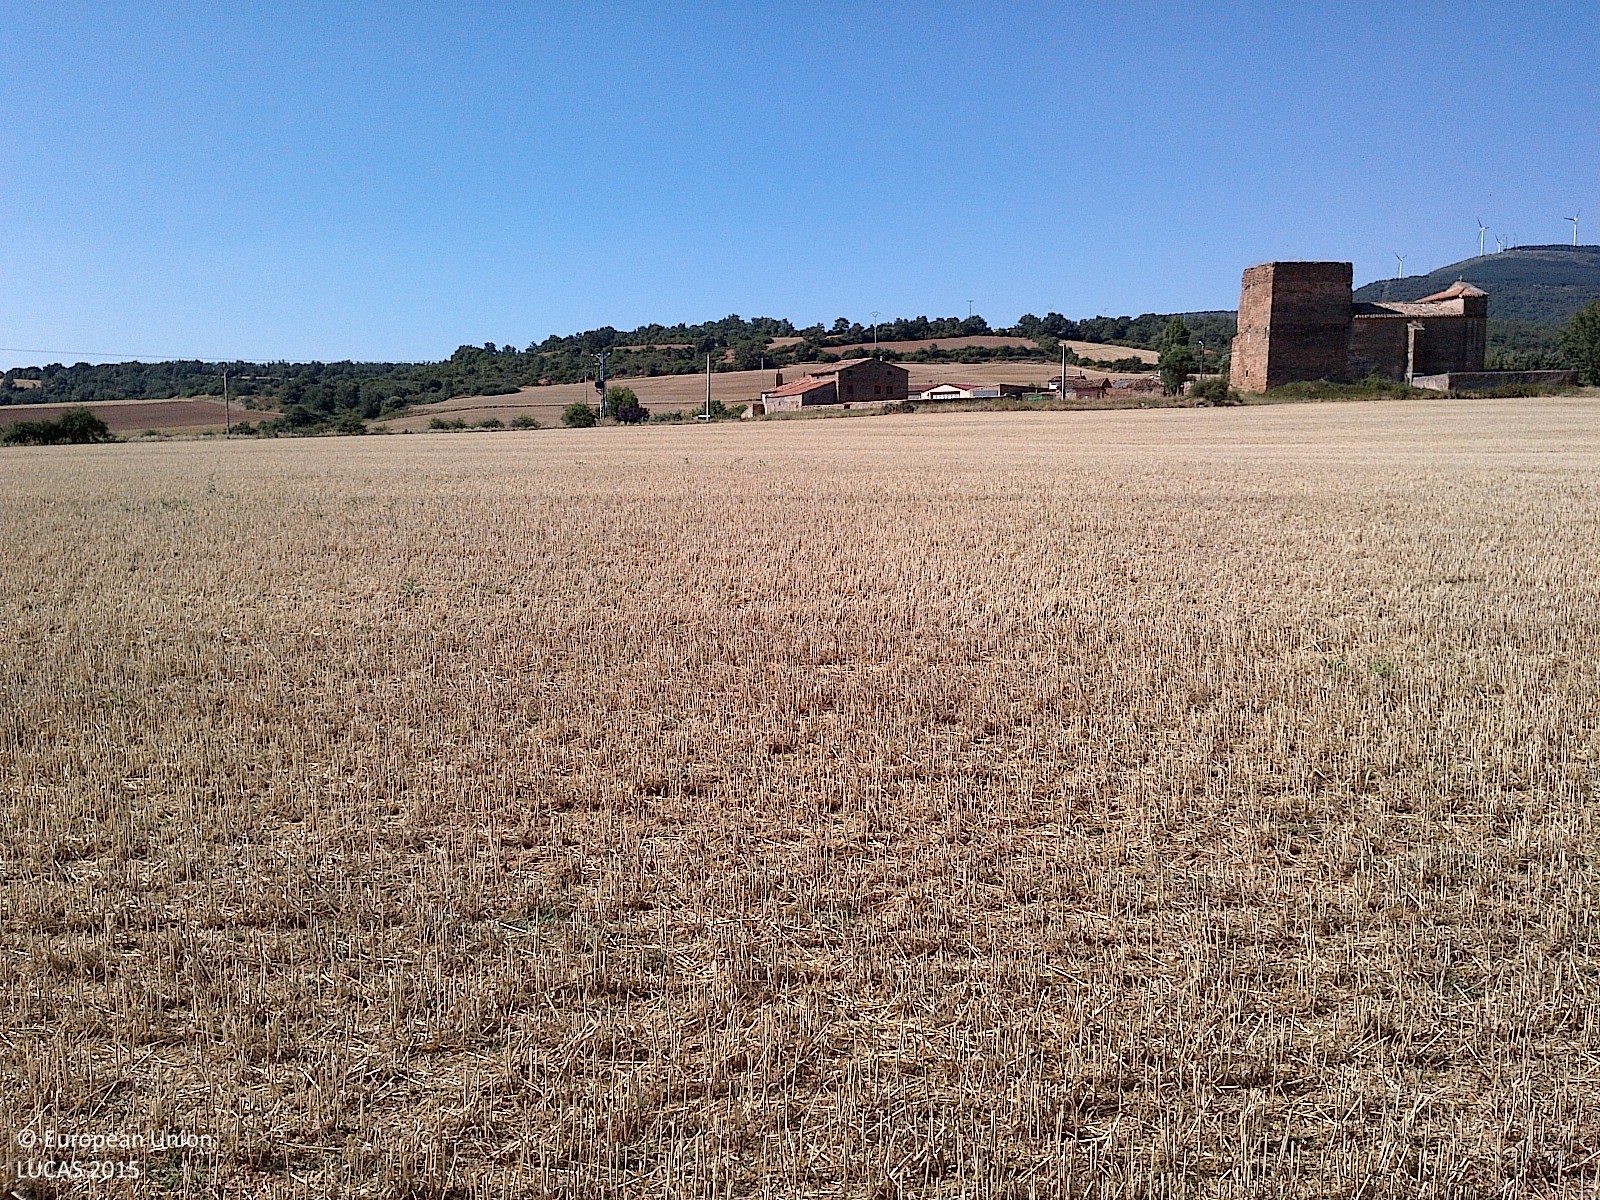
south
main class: Cropland
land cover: Common wheat
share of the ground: < 10 %
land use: Agriculture (excluding fallow land and kitchen gardens)
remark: Harvested field
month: July
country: ES
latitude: 41.8566
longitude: -2.0683
